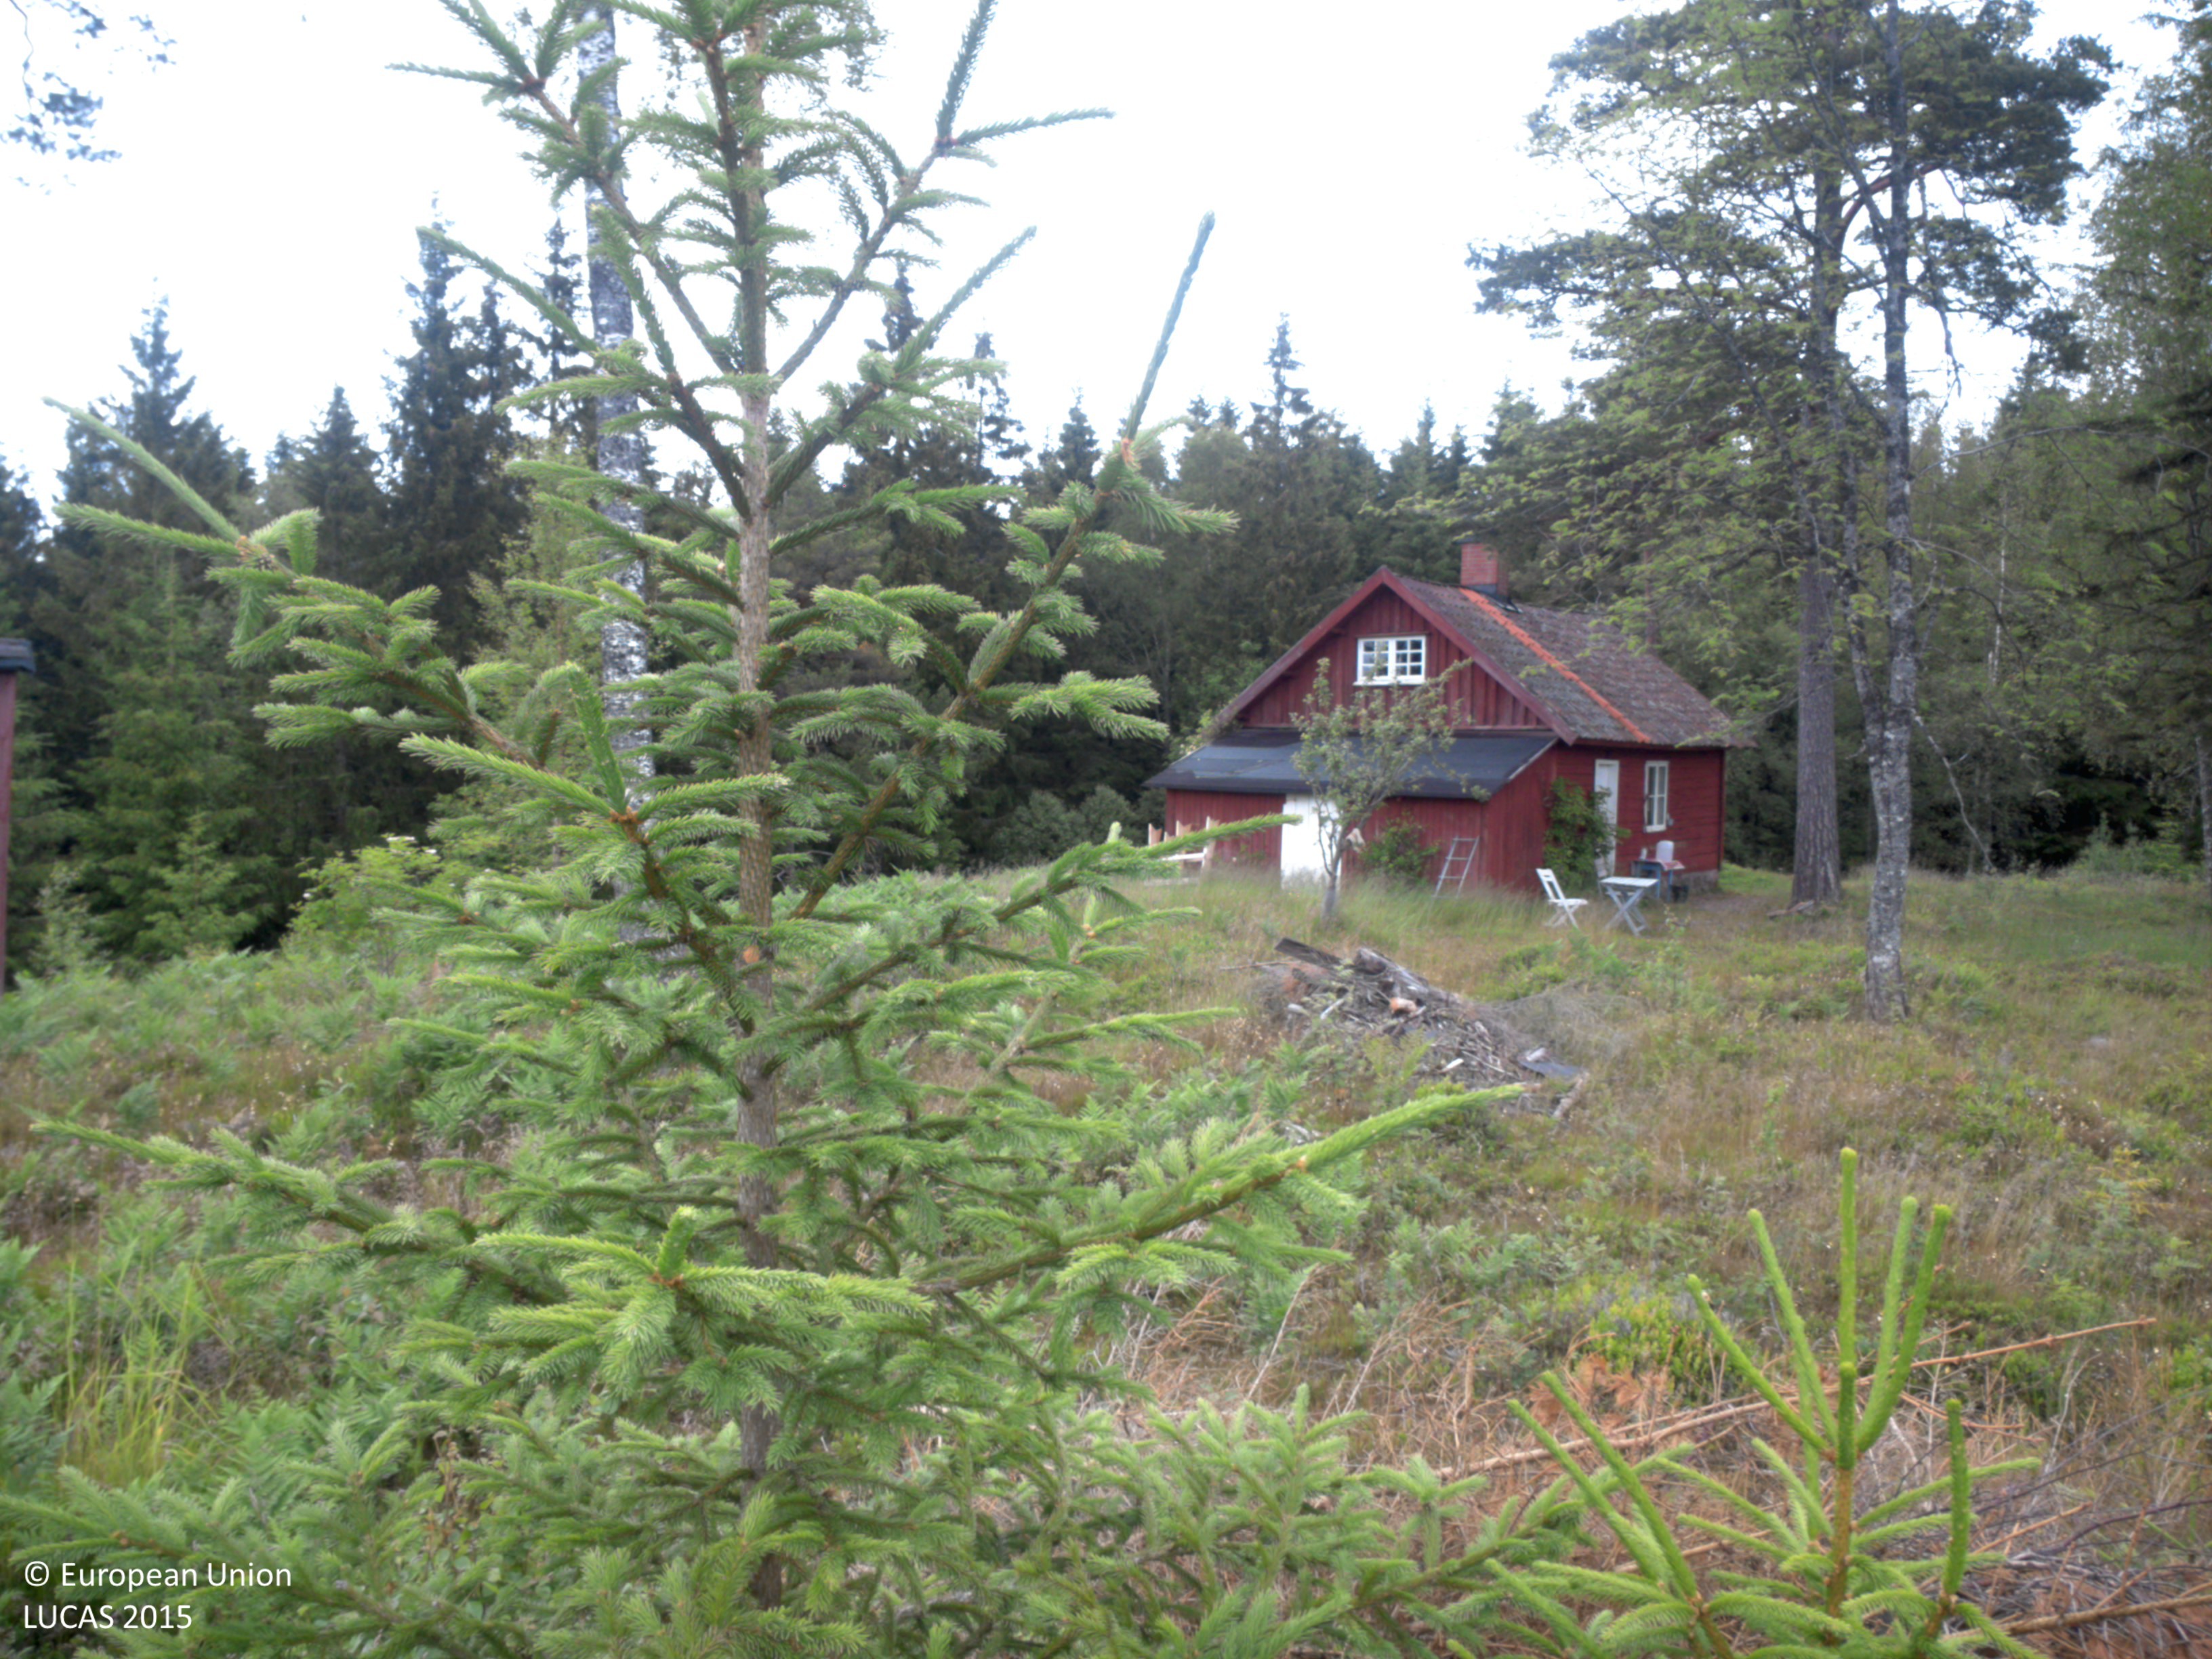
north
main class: Woodland
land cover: Spruce dominated mixed woodland
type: boreal forest
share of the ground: 50 - 75 %
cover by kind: shrubs 40 %, coniferous forest trees 30 %, broadleaved forest trees 20 %, herbaceous plants 10 %
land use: Forestry
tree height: < 5 m
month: June
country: SE
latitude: 58.9943
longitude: 12.1358
